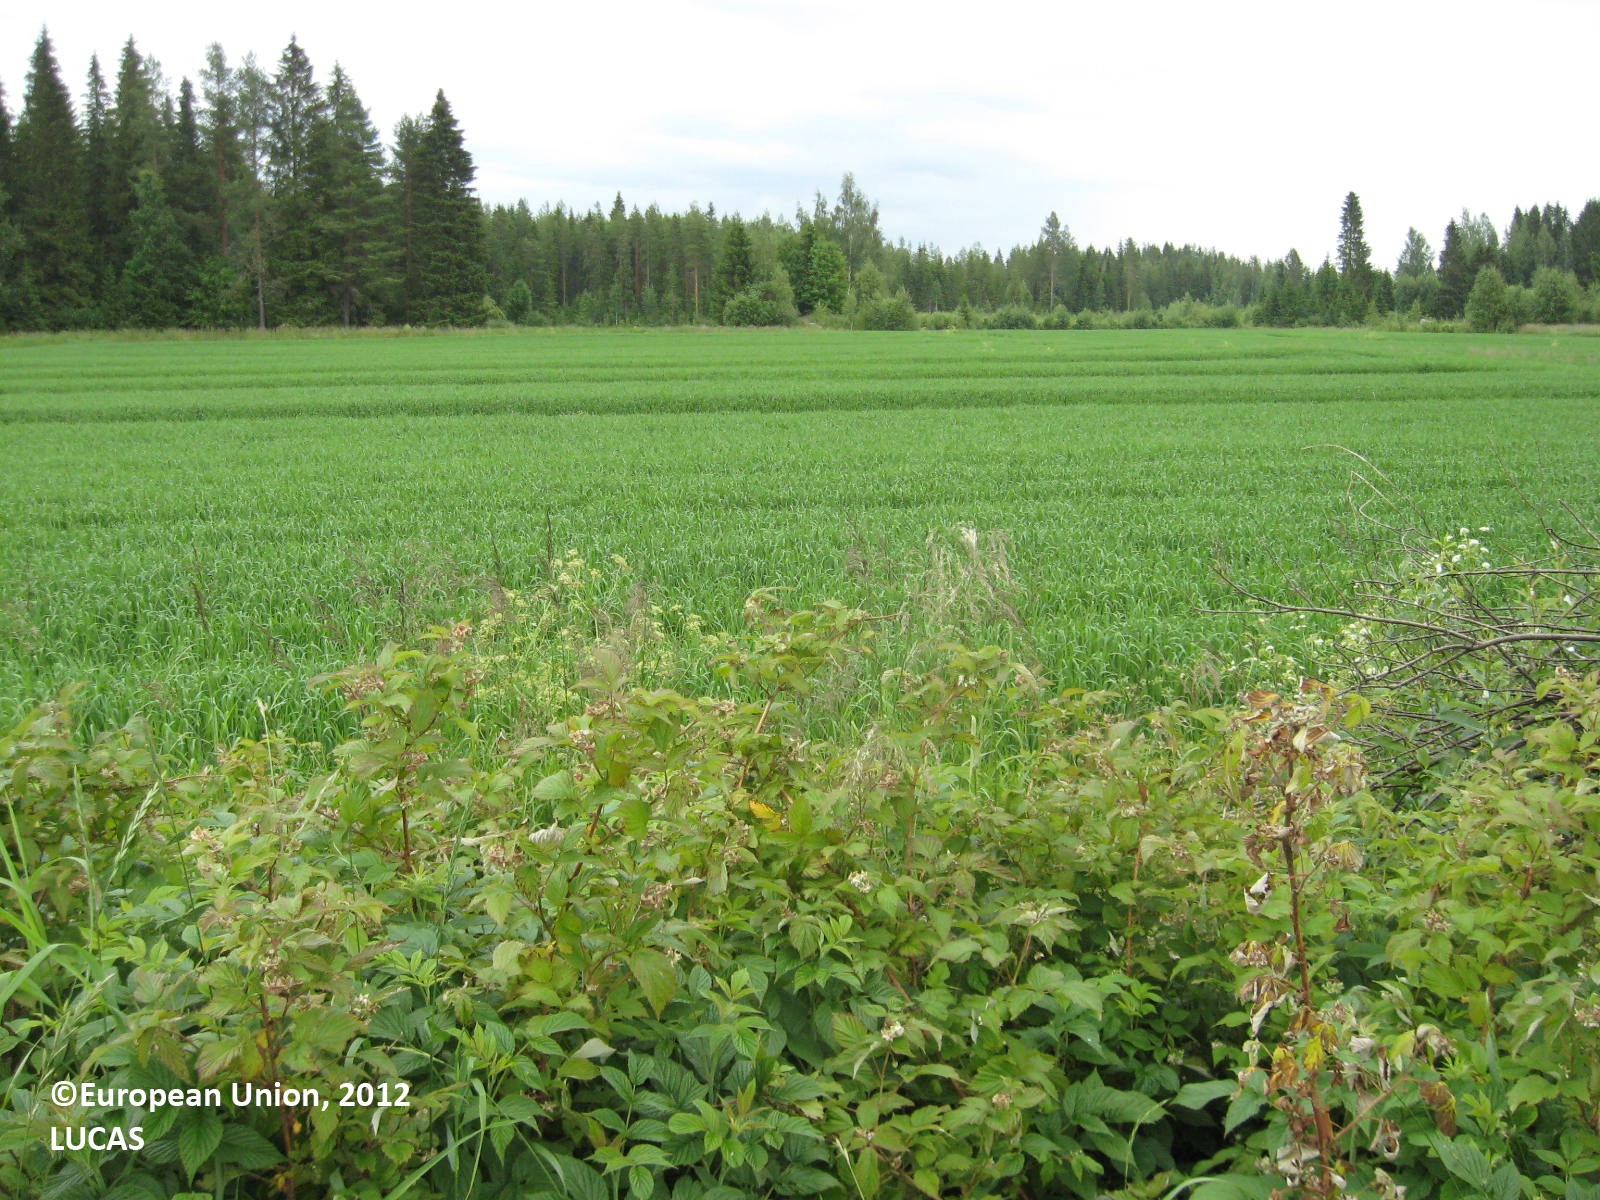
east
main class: Cropland
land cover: Barley
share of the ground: > 75 %
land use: Agriculture (excluding fallow land and kitchen gardens)
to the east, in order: Barley; Grass margins; Ditches and canals; Grass margins; Barley; Grass margins; Ditches and canals; Grass margins; Barley; Grass margins; Ditches and canals; Grass margins; Oats; Ditches and canals; Oats; Ditches and canals; Oats; Ditches and canals; Oats; Ditches and canals; Oats; Ditches and canals; Oats; Ditches and canals; Oats; Ditches and canals; Oats; Grass margins; Ditches and canals; Grassland without tree/shrub cover; Ditches and canals; Oats; Ditches and canals; Other mixed woodland
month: July
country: FI
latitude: 62.5126
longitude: 22.8985
